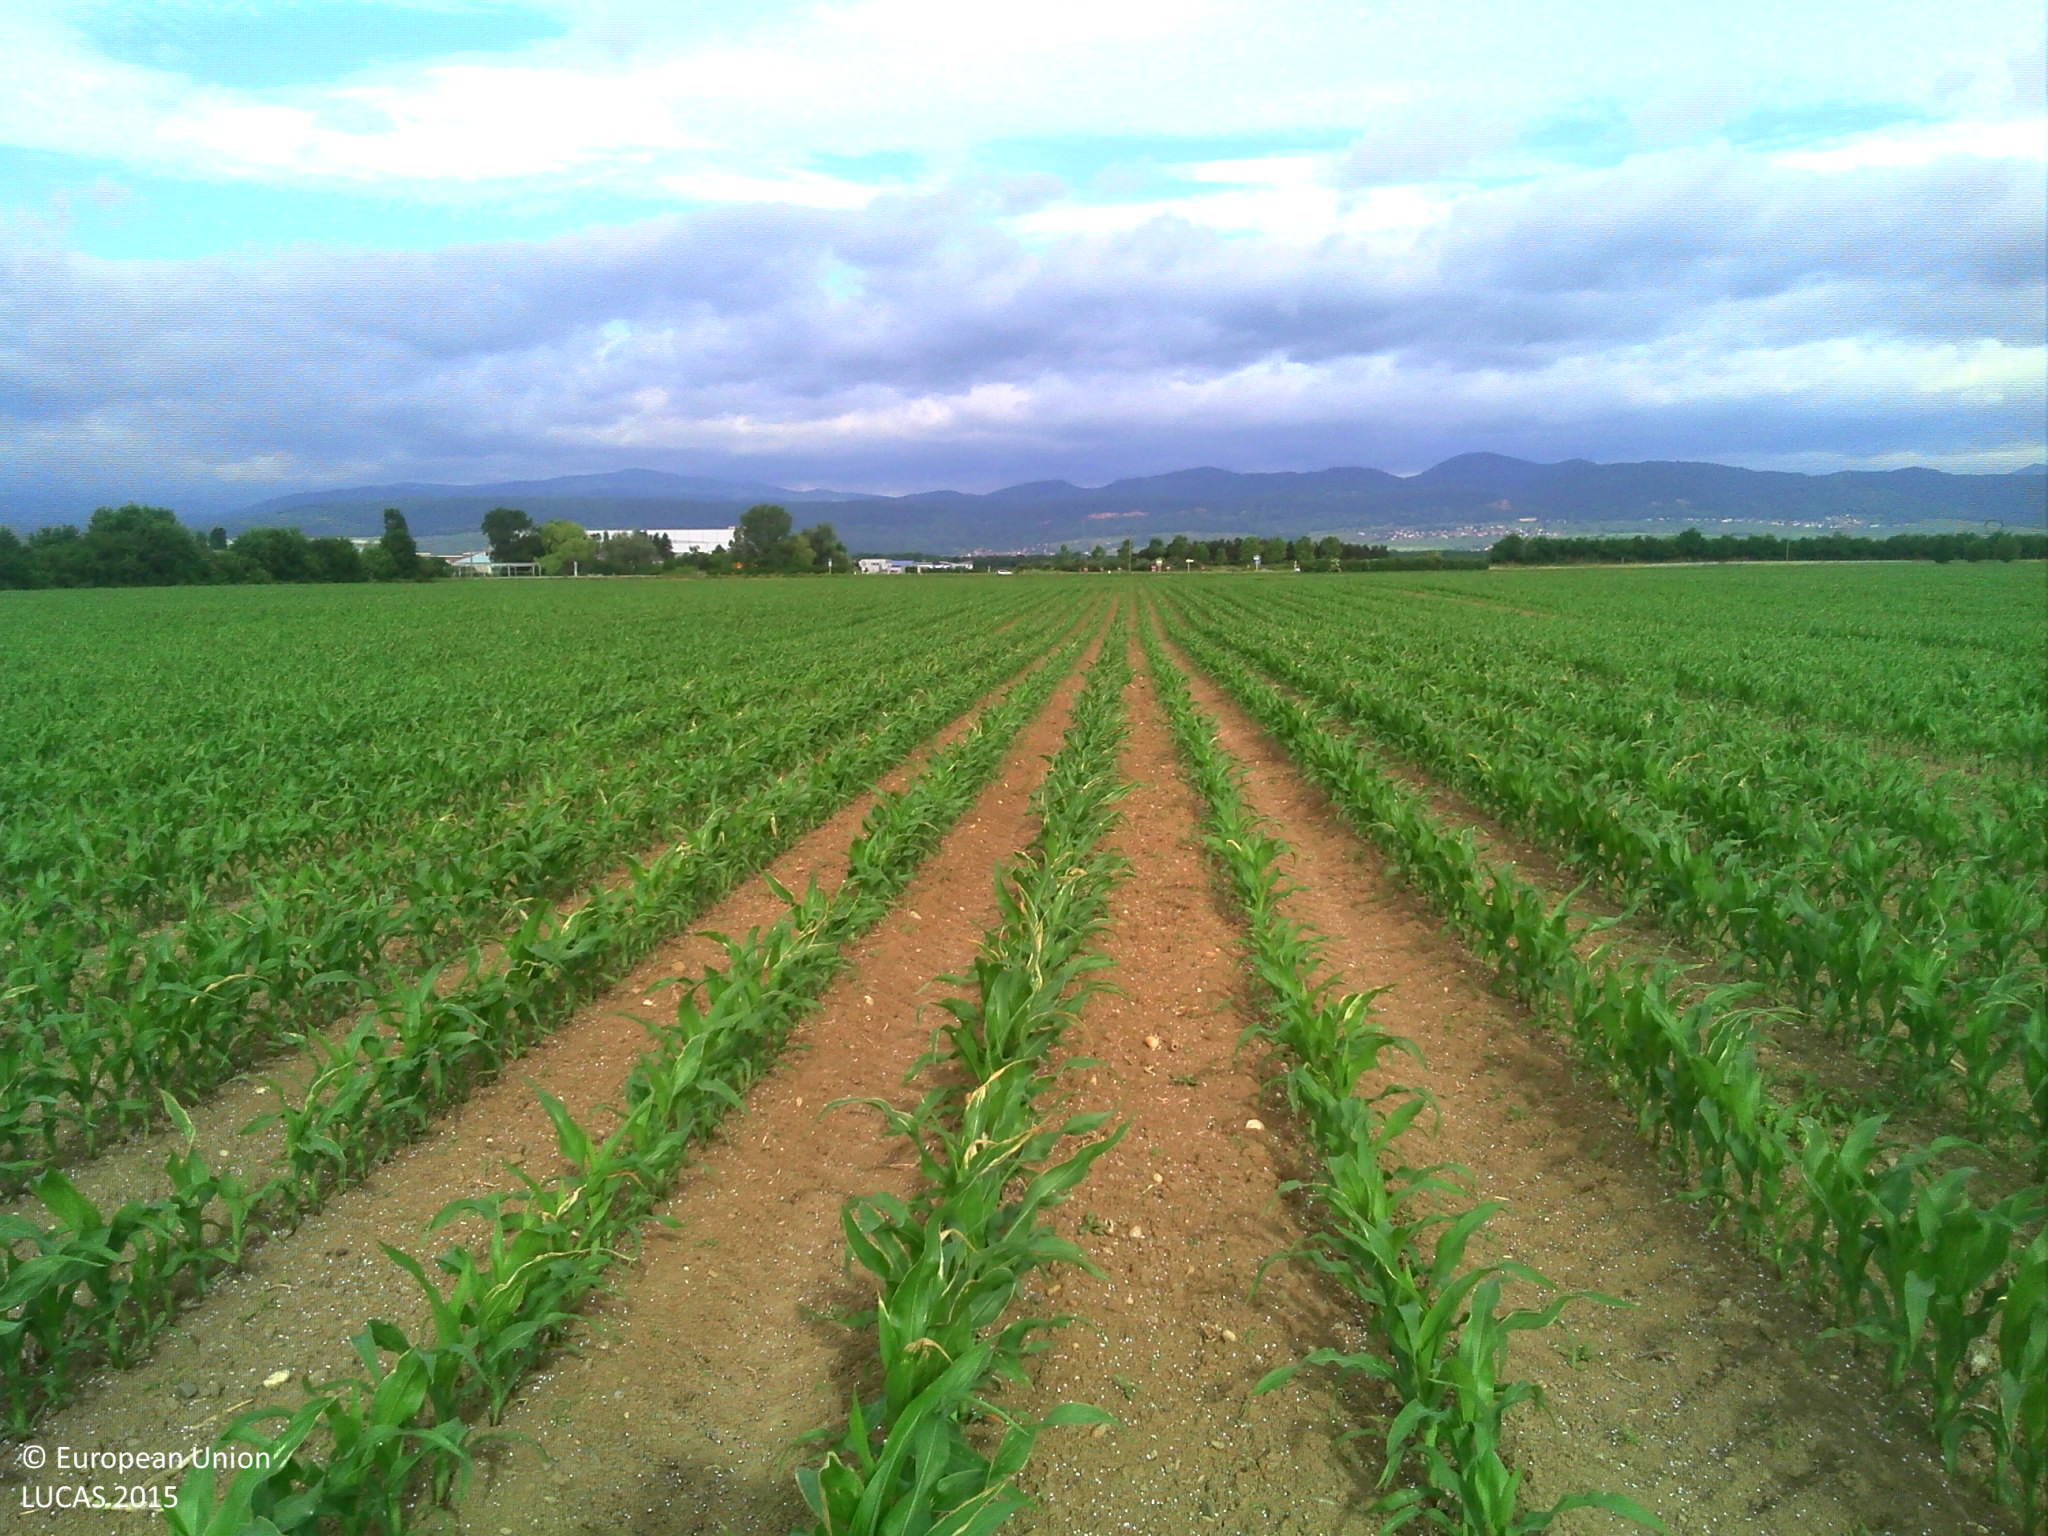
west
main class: Cropland
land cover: Maize
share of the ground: 10 - 25 %
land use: Agriculture (excluding fallow land and kitchen gardens)
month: June
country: FR
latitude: 47.9946
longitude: 7.3880
